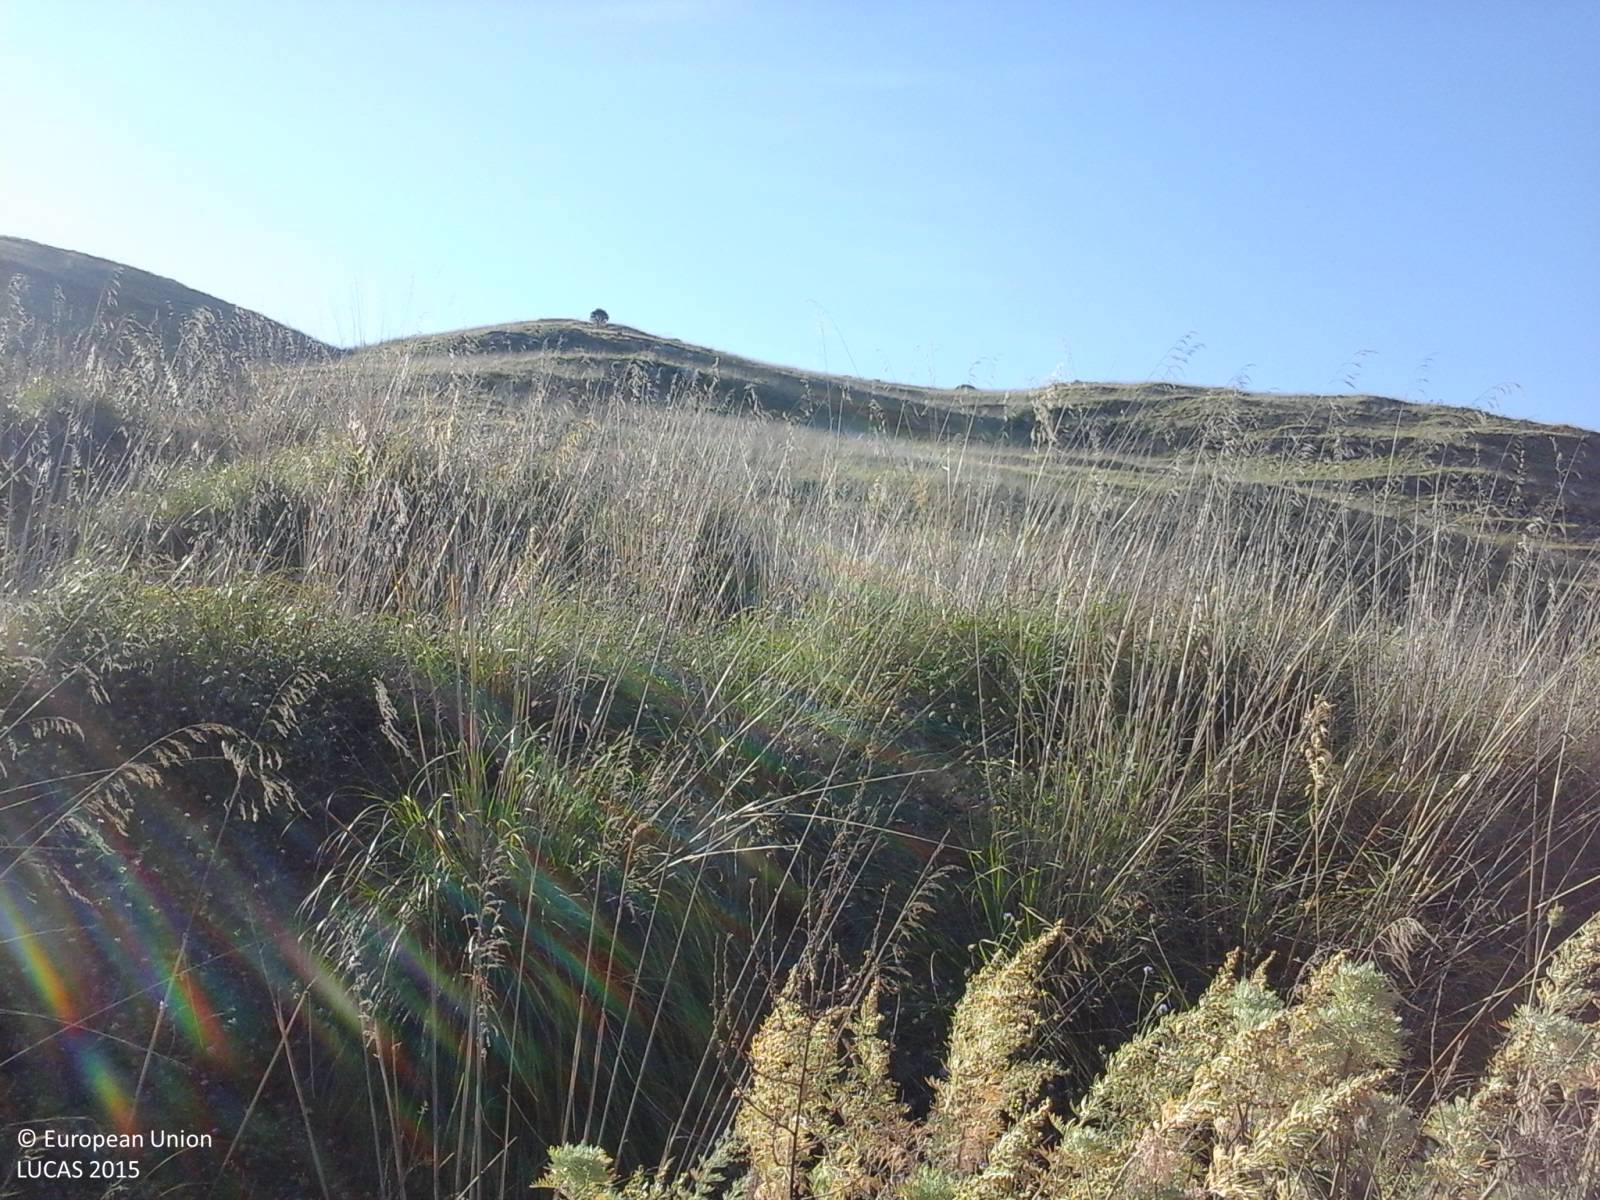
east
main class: Shrubland
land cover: Shrubland without tree cover
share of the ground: > 75 %
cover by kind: shrubs 85 %, herbaceous plants 15 %
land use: Semi-natural and natural areas not in use
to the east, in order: Shrubland without tree cover
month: June
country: IT
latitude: 37.9561
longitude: 12.9491
